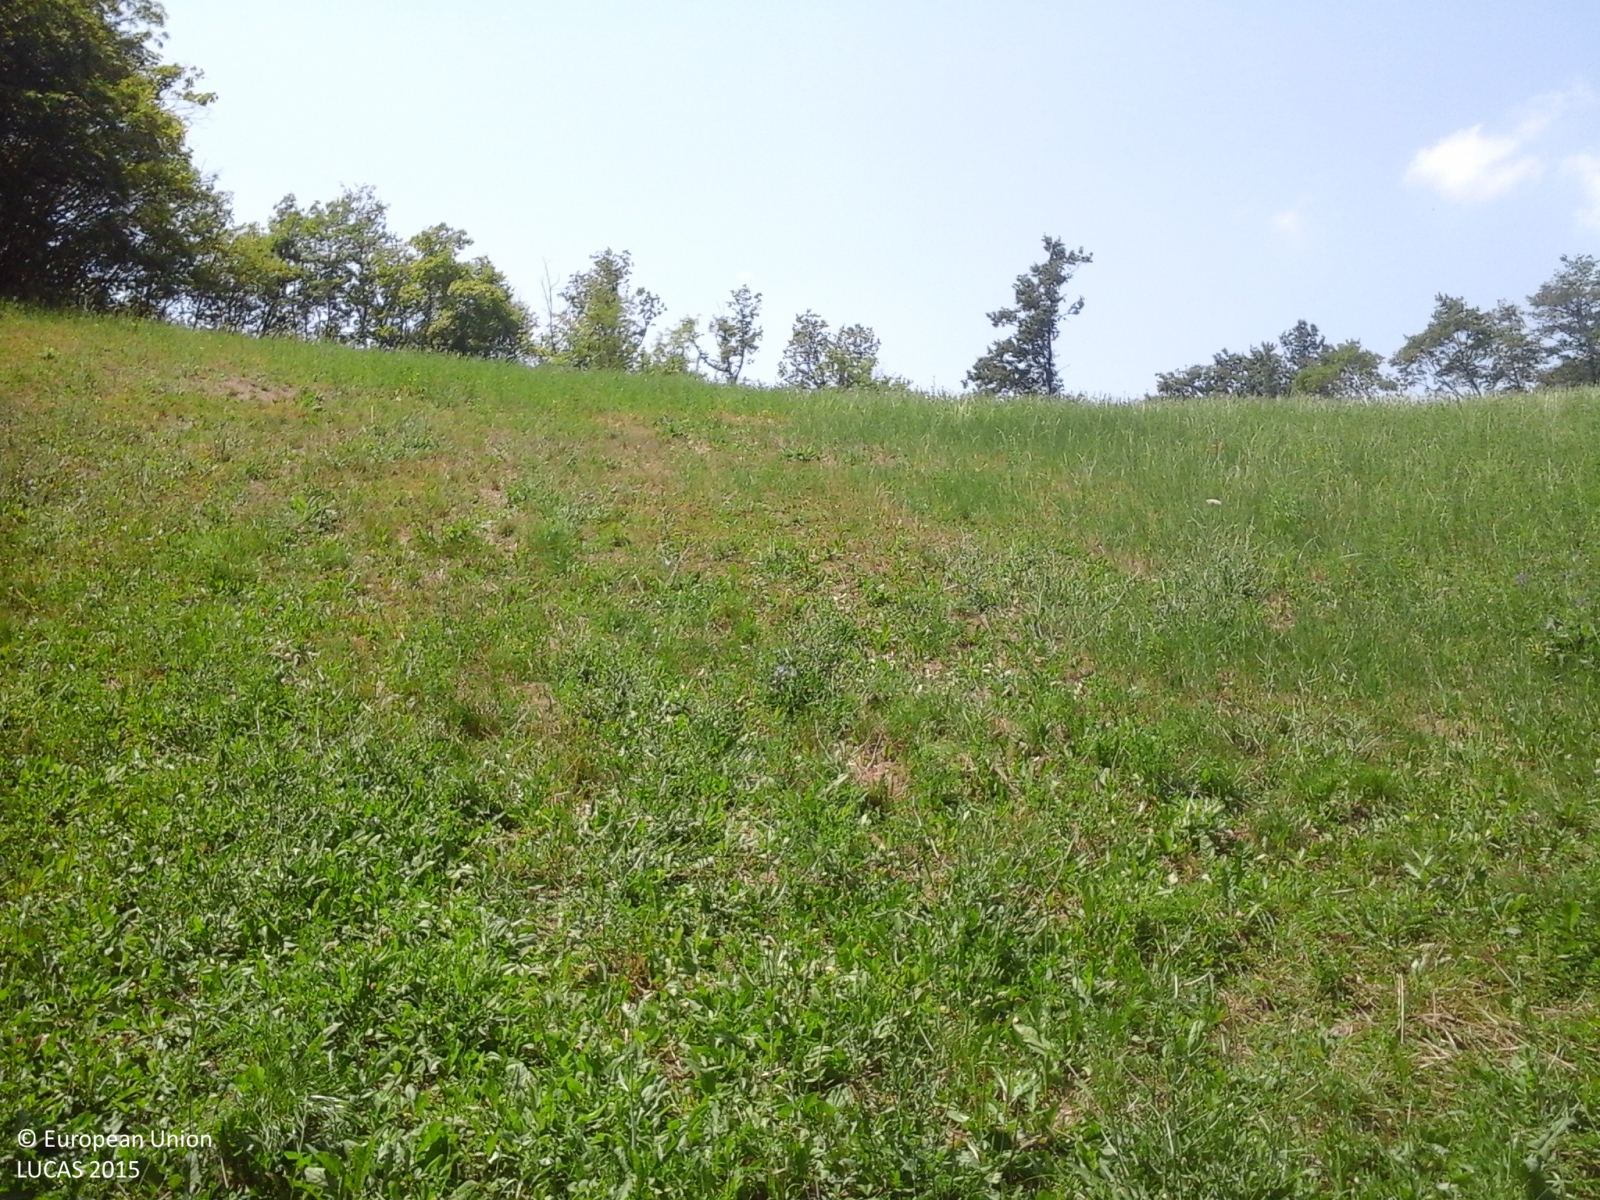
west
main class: Grassland
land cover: Grassland without tree/shrub cover
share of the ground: > 75 %
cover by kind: herbaceous plants 100 %
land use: Agriculture (excluding fallow land and kitchen gardens)
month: July
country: IT
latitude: 44.4764
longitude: 10.2885
